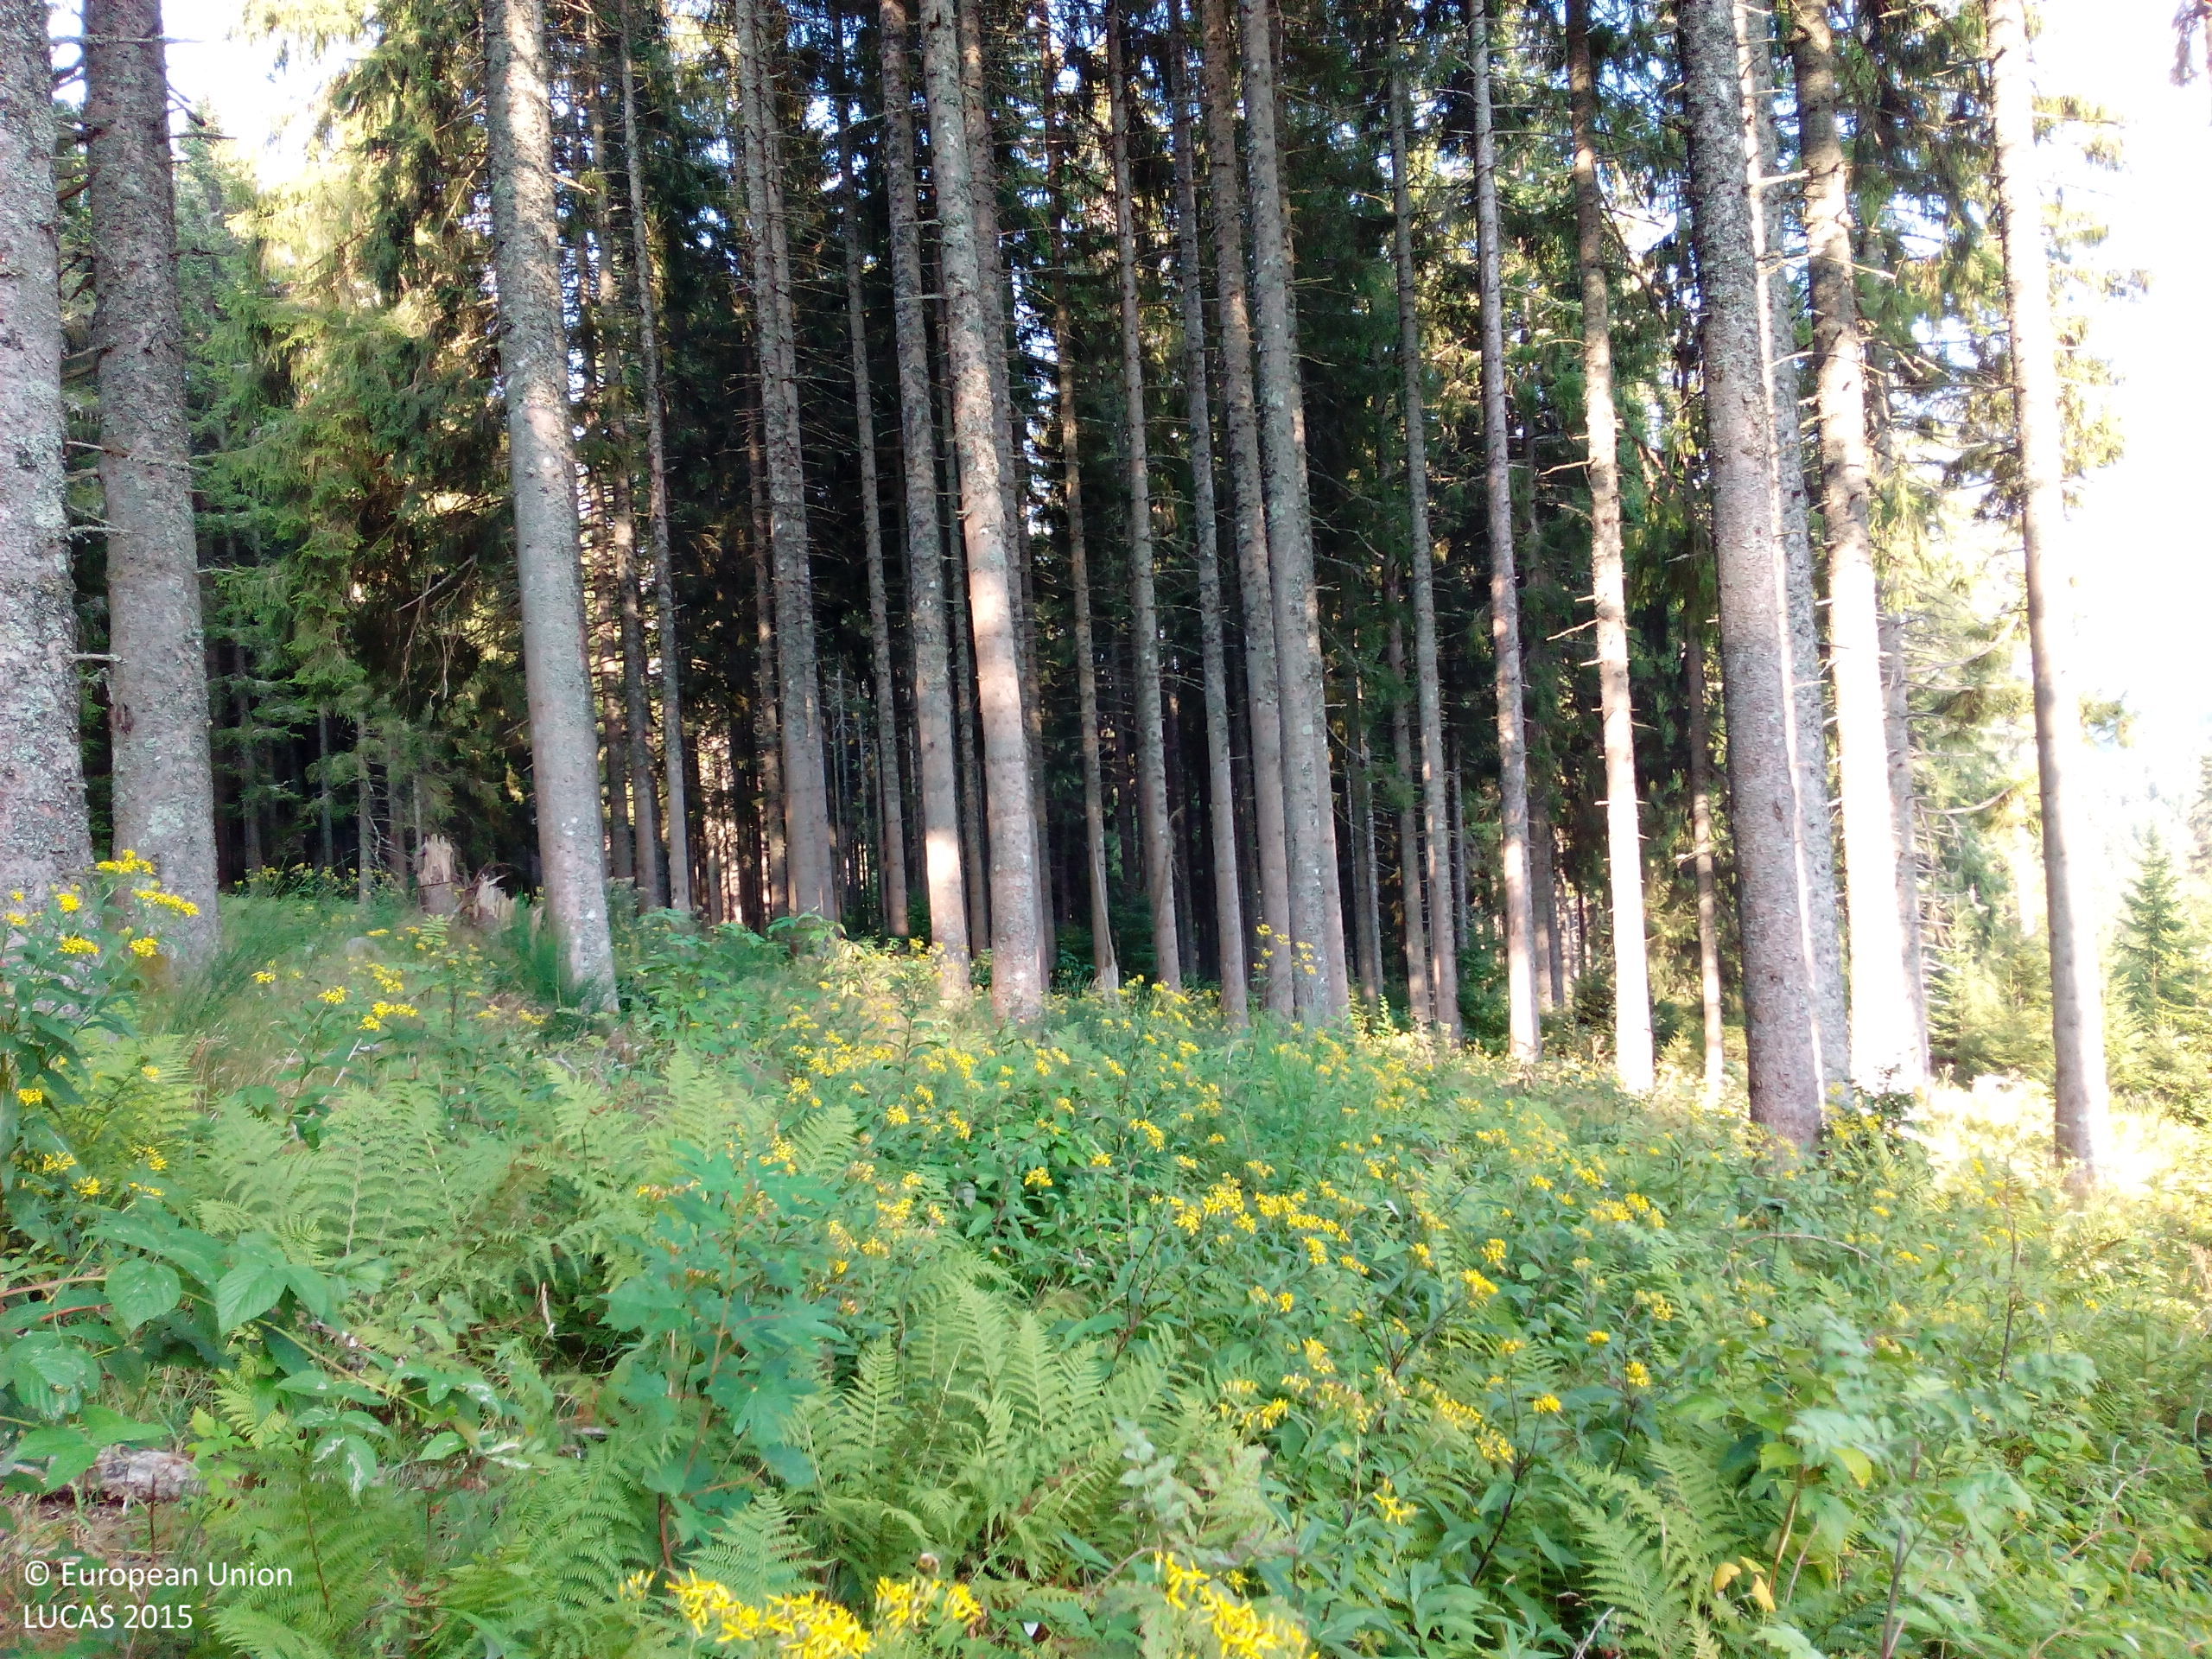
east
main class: Woodland
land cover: Spruce dominated coniferous woodland
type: hemiboreal forest and nemoral coniferous forest and mixed broadleaved-coniferous forest
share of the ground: 50 - 75 %
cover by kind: coniferous forest trees 60 %, shrubs 20 %, herbaceous plants 20 %
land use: Forestry
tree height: > 5 m
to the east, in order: Spruce dominated coniferous woodland; Tracks; Spruce dominated coniferous woodland
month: August
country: DE
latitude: 47.8475
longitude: 8.1170
